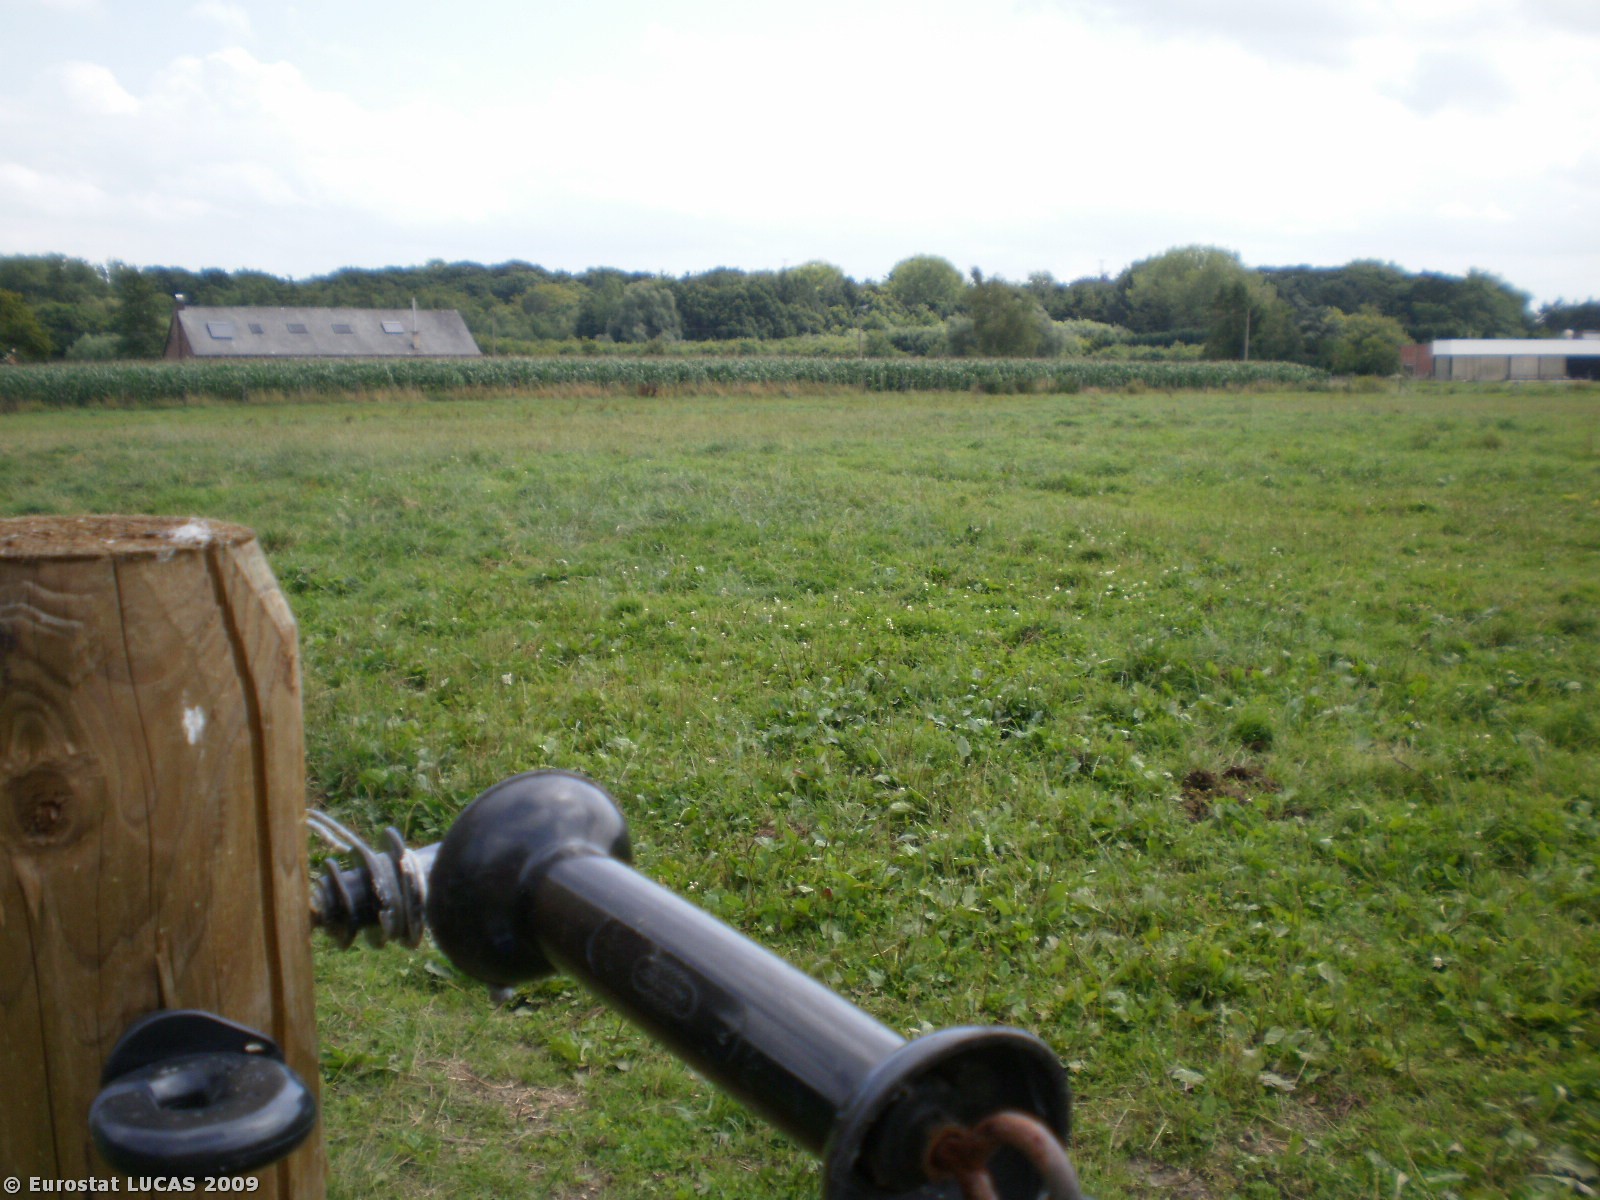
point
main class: Grassland
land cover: Grassland without tree/shrub cover
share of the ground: > 75 %
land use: Agriculture (excluding fallow land and kitchen gardens)
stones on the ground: < 10 %
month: July
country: BE
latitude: 51.0305
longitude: 4.2486
